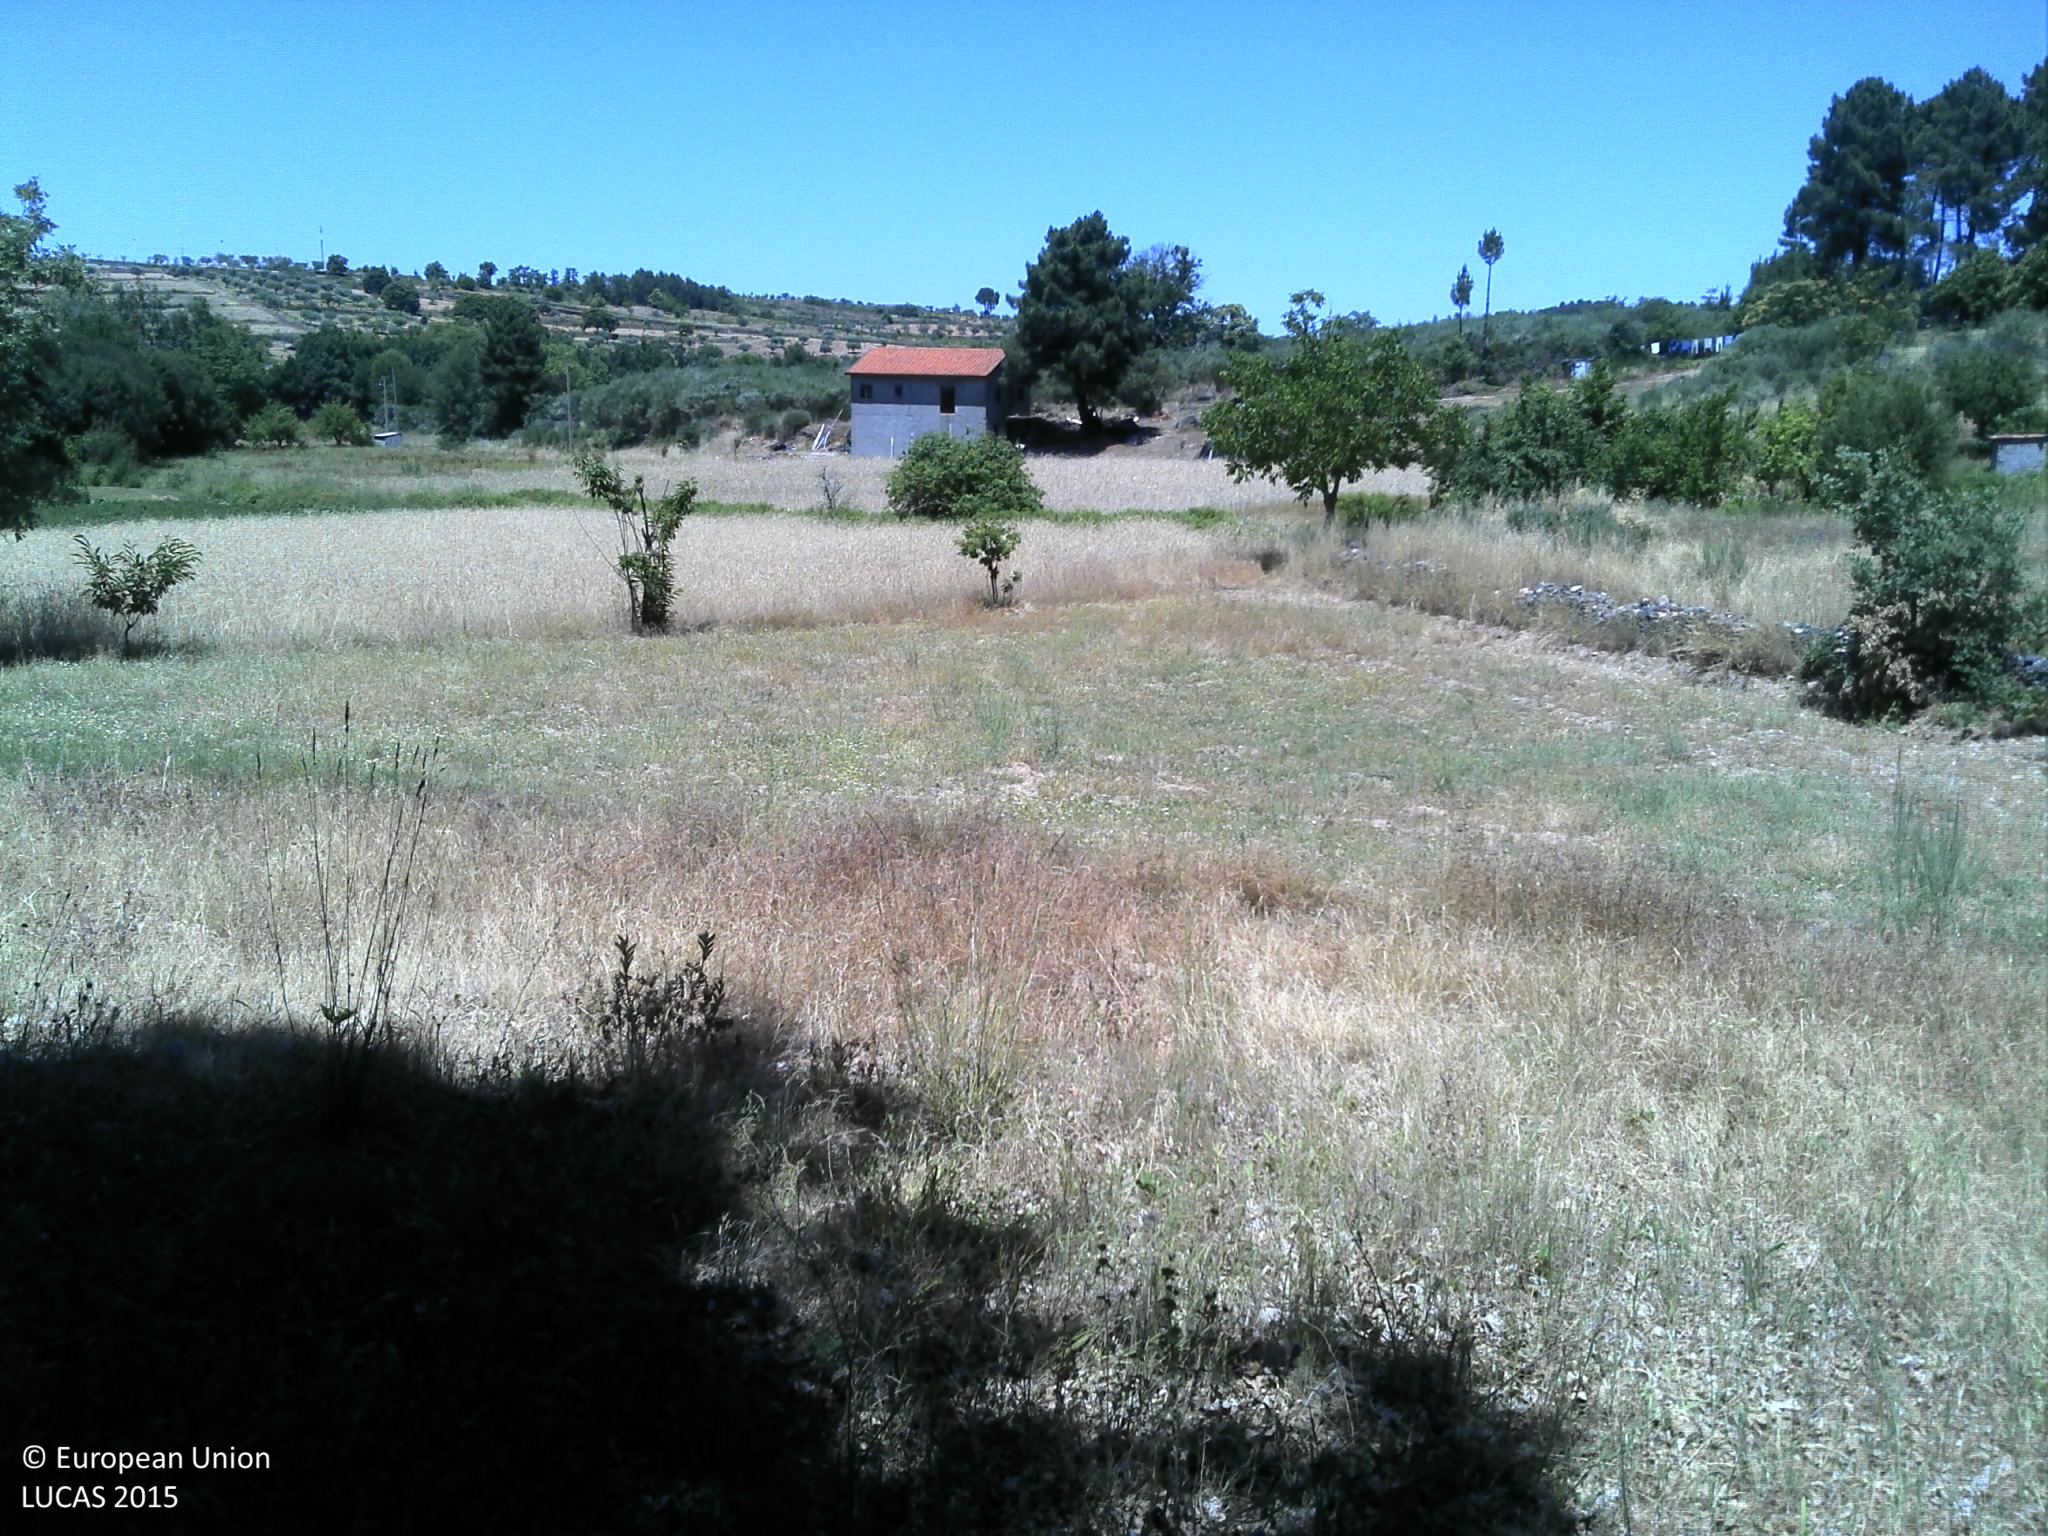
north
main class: Grassland
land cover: Spontaneously vegetated surfaces
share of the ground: > 75 %
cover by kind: herbaceous plants 95 %, unconsolidated bare surface 5 %
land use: Fallow land
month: June
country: PT
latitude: 40.7825
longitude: -7.3046
